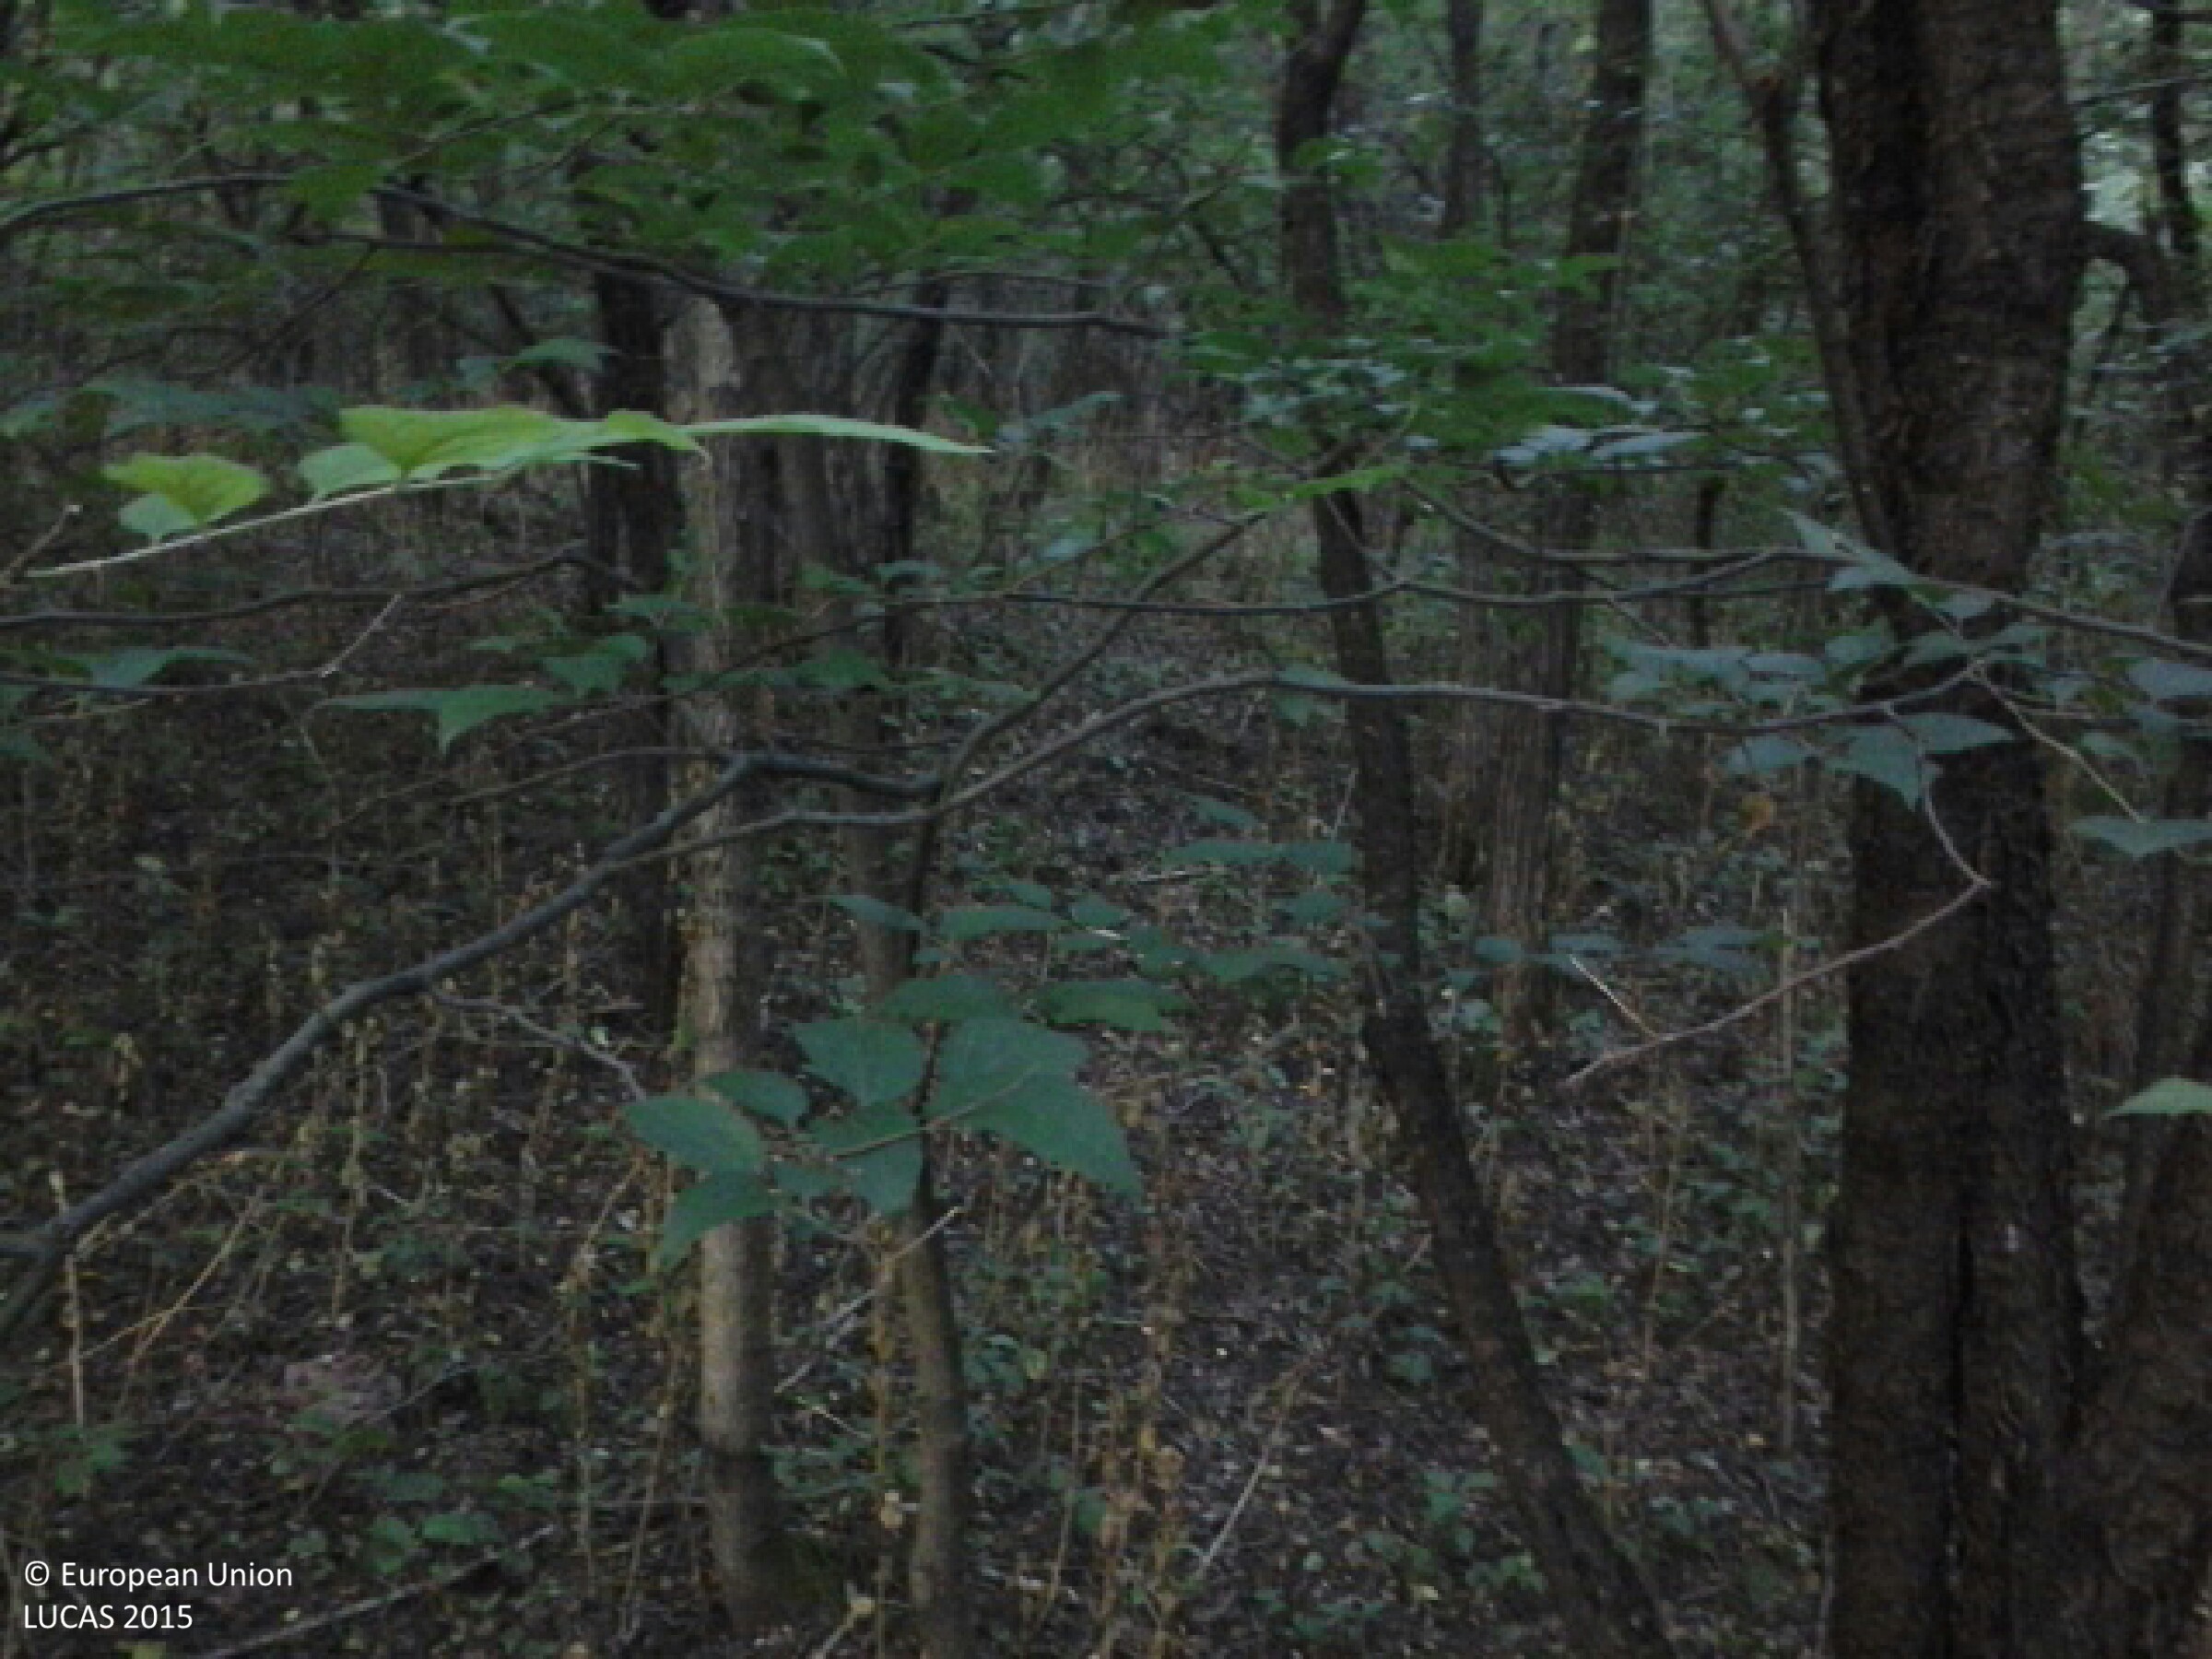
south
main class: Woodland
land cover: Broadleaved woodland
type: mesophytic deciduous forest
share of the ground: > 75 %
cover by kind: broadleaved forest trees 95 %, herbaceous plants 5 %
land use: Forestry
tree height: > 5 m
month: August
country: HU
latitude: 47.7298
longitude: 18.0518
